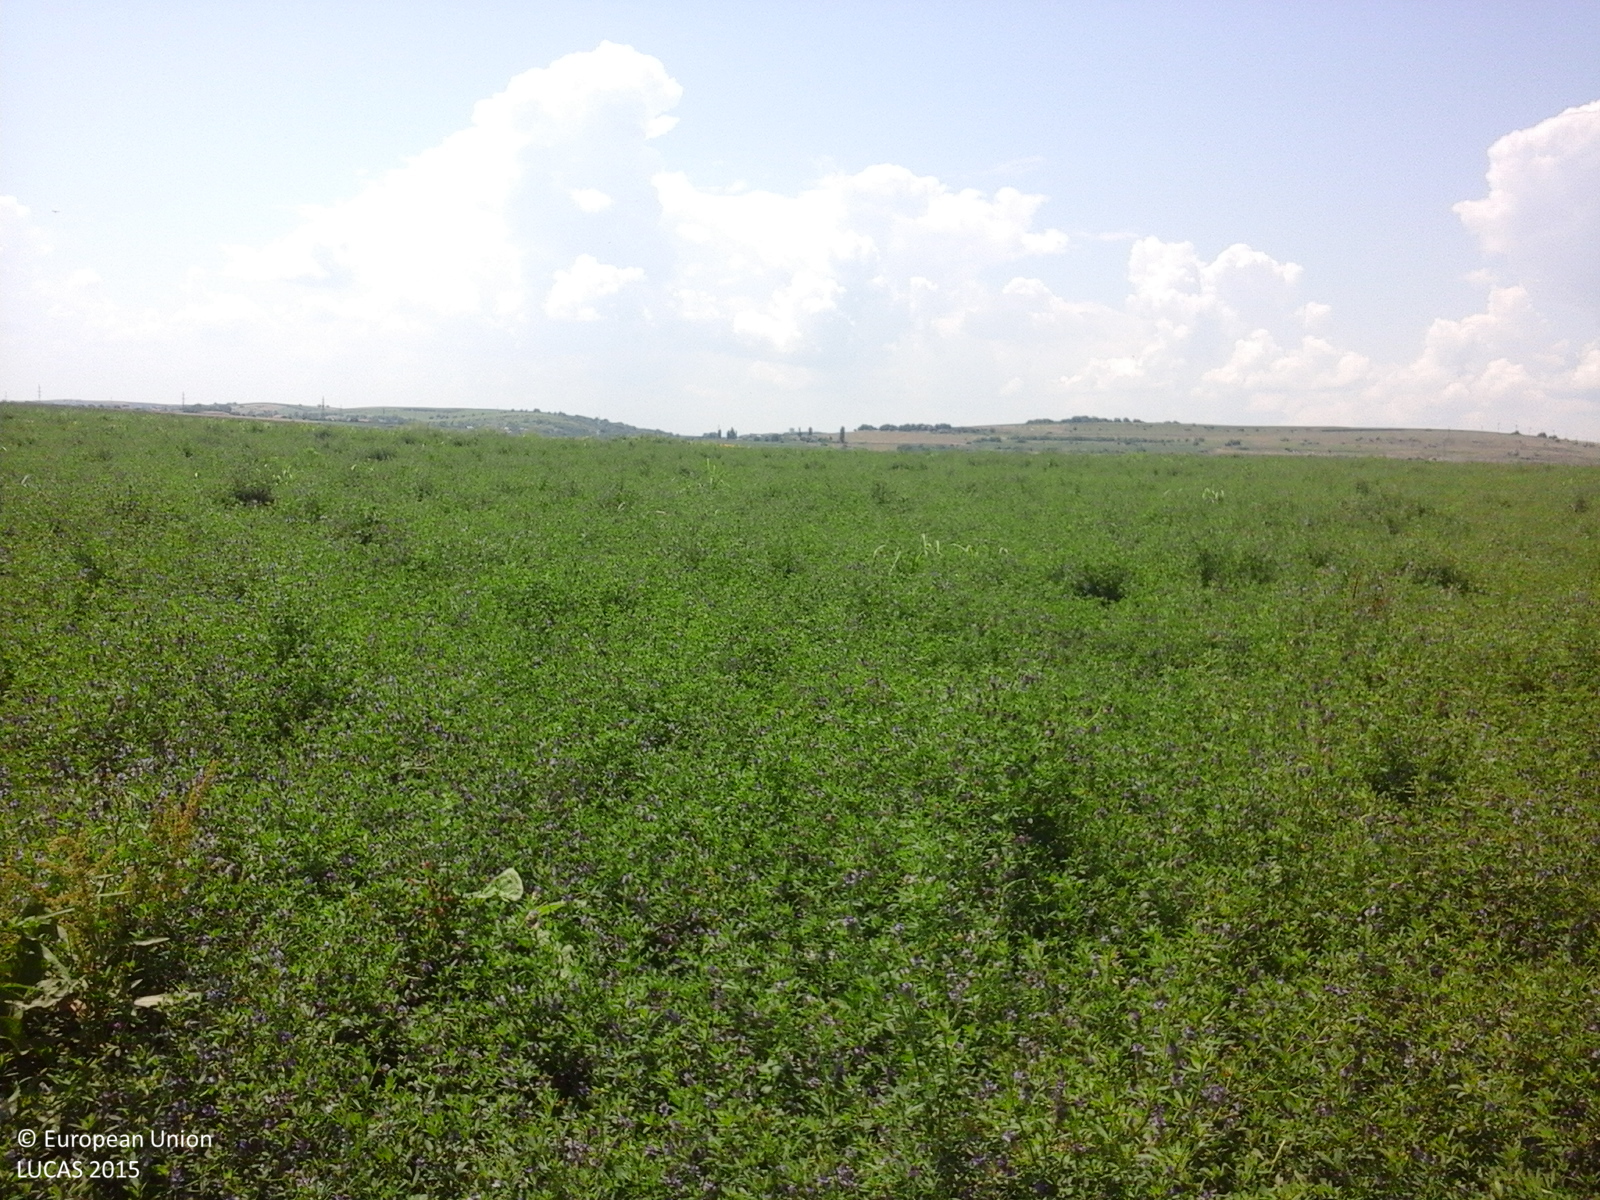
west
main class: Cropland
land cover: Lucerne
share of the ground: > 75 %
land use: Agriculture (excluding fallow land and kitchen gardens)
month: July
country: RO
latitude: 43.9954
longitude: 26.0227
